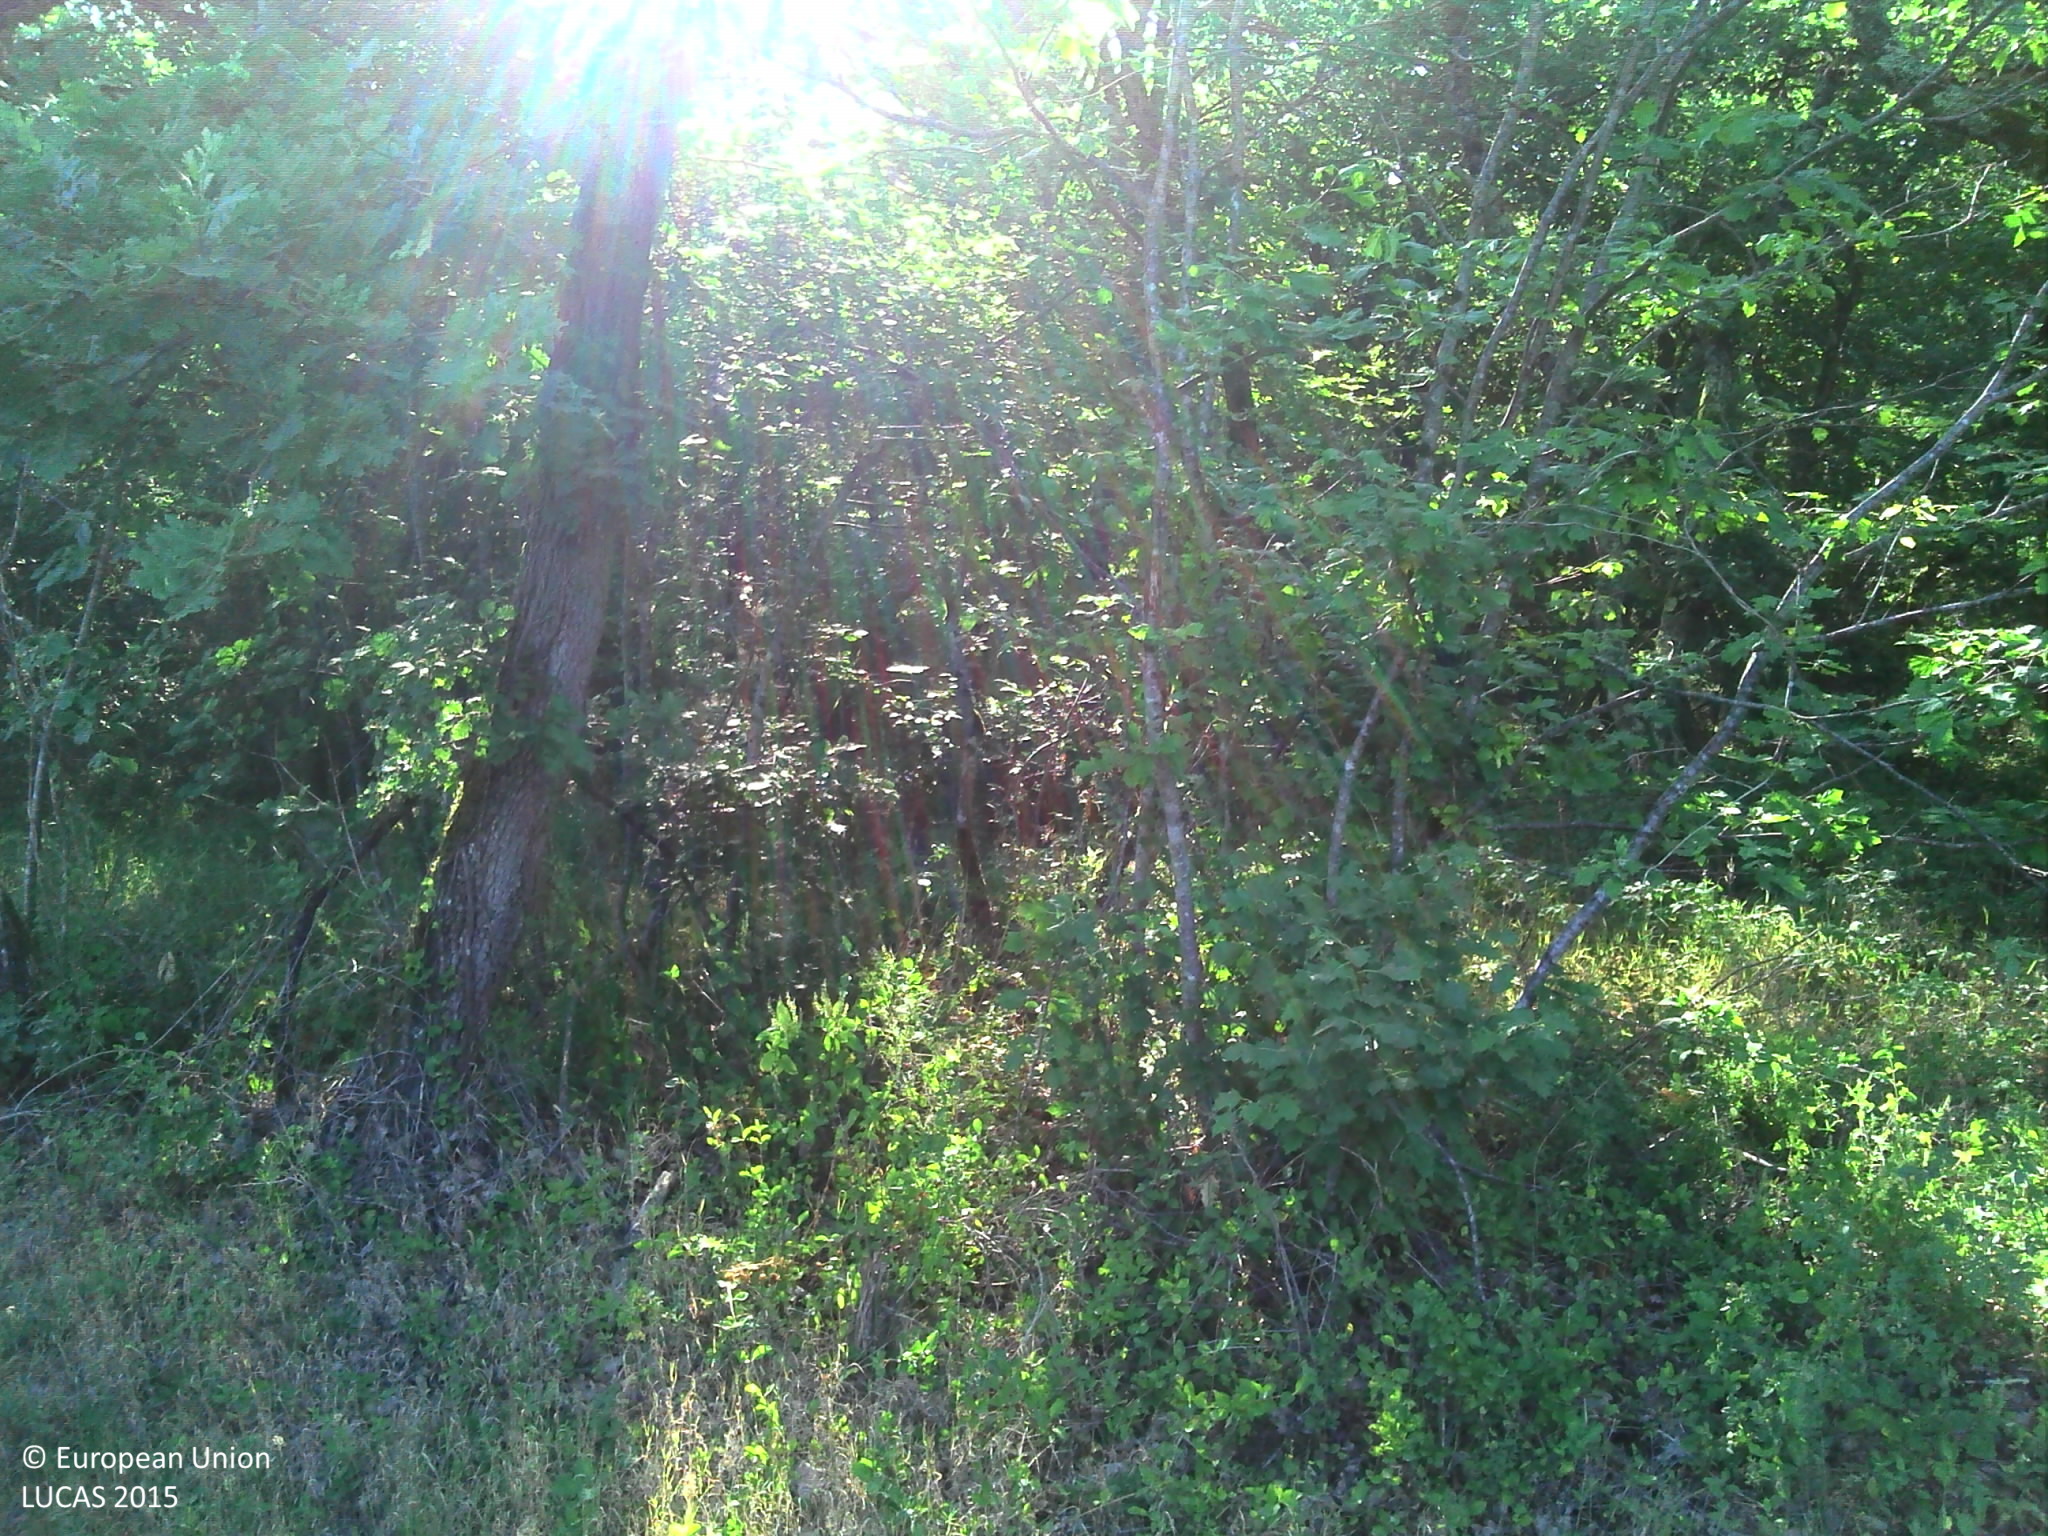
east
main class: Grassland
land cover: Spontaneously vegetated surfaces
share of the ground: > 75 %
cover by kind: herbaceous plants 60 %, lichens and mosses 15 %, shrubs 5 %
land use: Forestry
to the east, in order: Spontaneously vegetated surfaces; Tracks; Grass margins; Broadleaved woodland; Tracks; Broadleaved woodland; Tracks; Broadleaved woodland
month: June
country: FR
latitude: 43.7711
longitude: 1.5669
